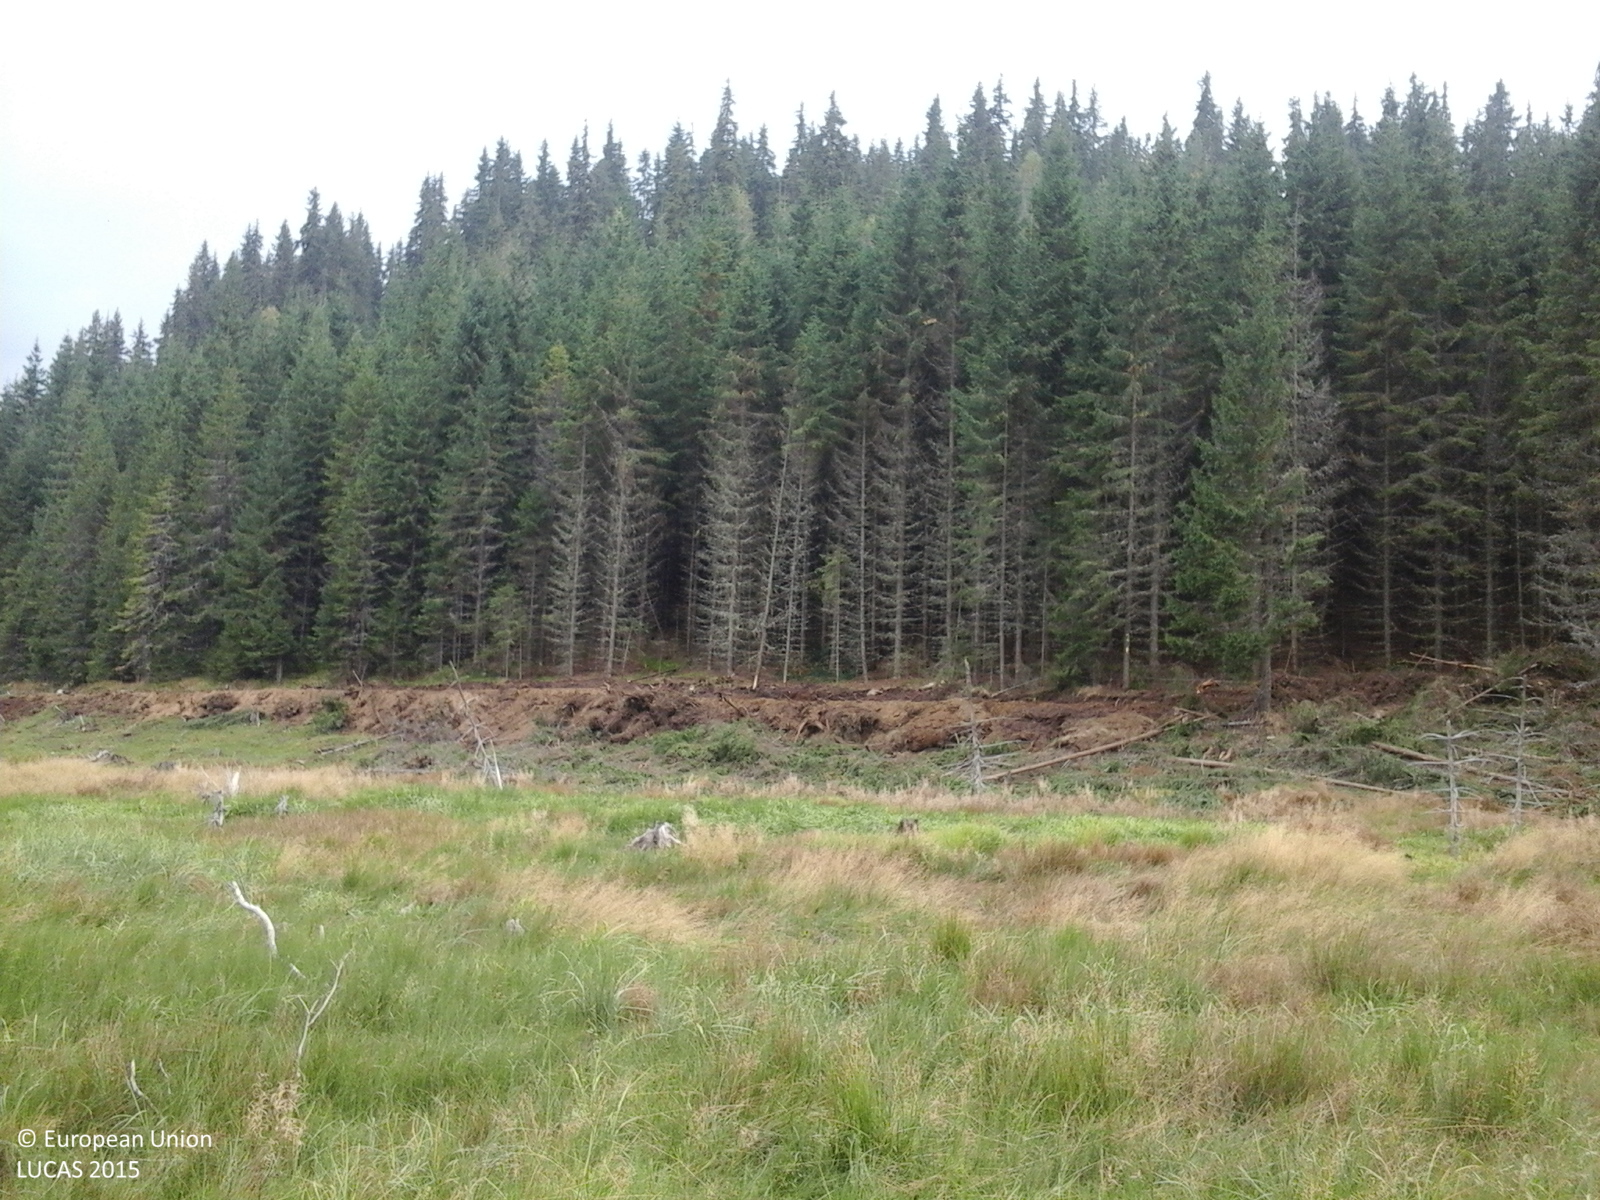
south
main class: Grassland
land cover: Grassland without tree/shrub cover
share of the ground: > 75 %
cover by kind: herbaceous plants 100 %
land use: Agriculture (excluding fallow land and kitchen gardens)
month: September
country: RO
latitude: 45.4312
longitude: 23.6765
